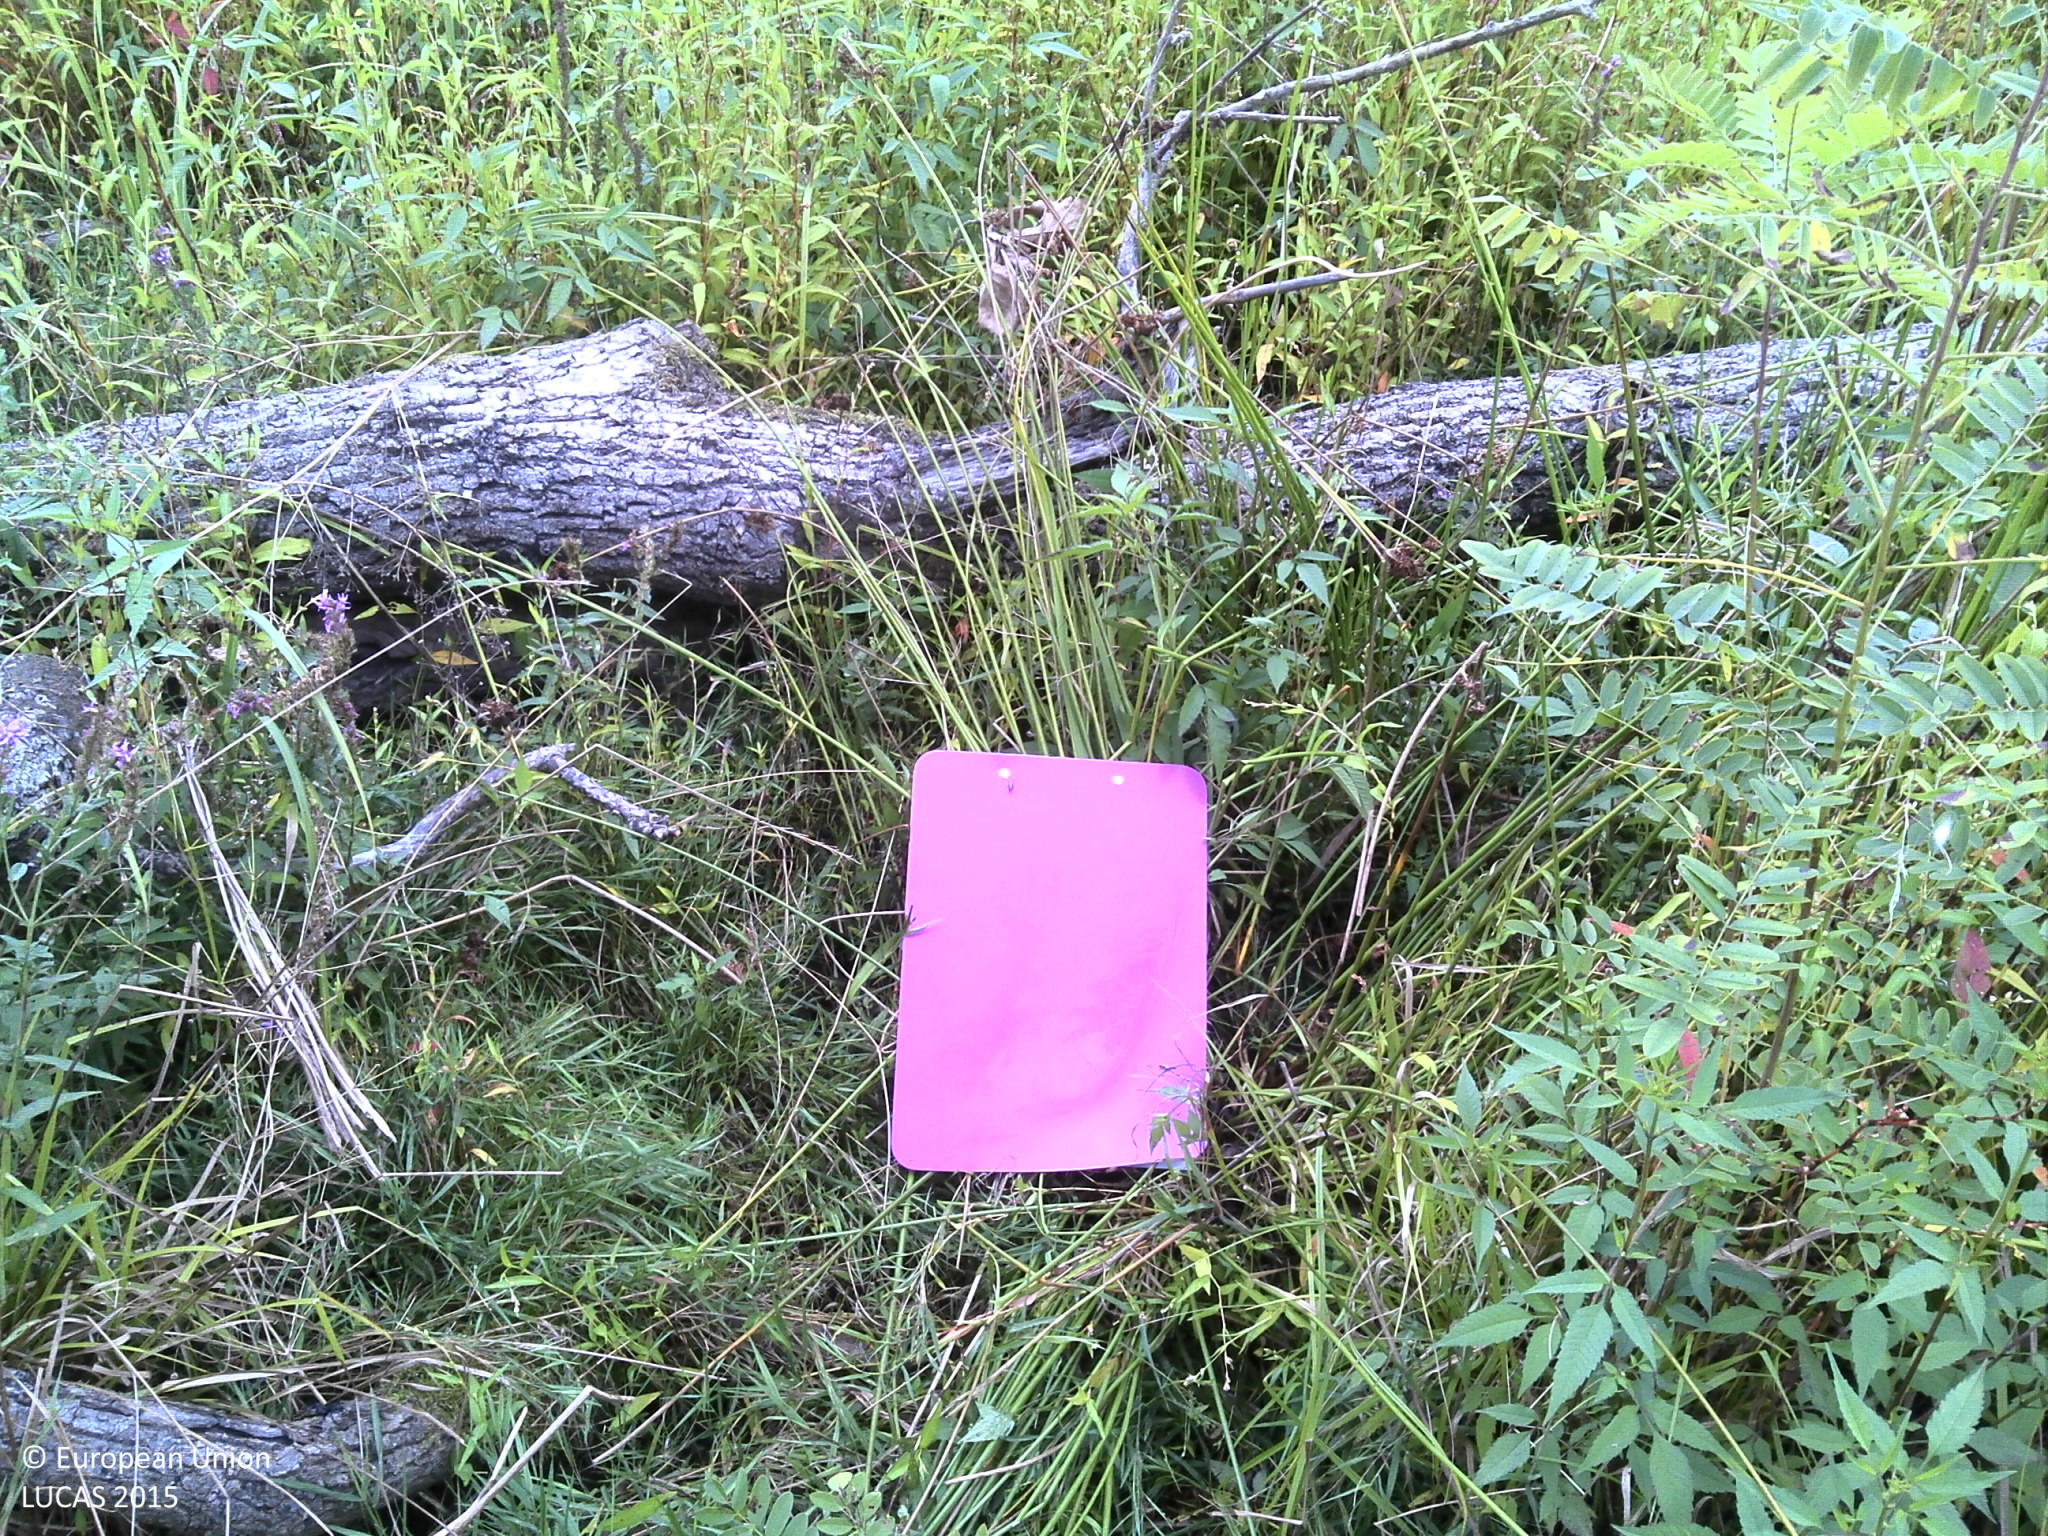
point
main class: Woodland
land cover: Broadleaved woodland
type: acidophilous oak and oak-birch forest
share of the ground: 25 - 50 %
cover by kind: herbaceous plants 60 %, broadleaved forest trees 40 %
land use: Forestry
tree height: > 5 m
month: August
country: HR
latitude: 45.2887
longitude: 16.7429
